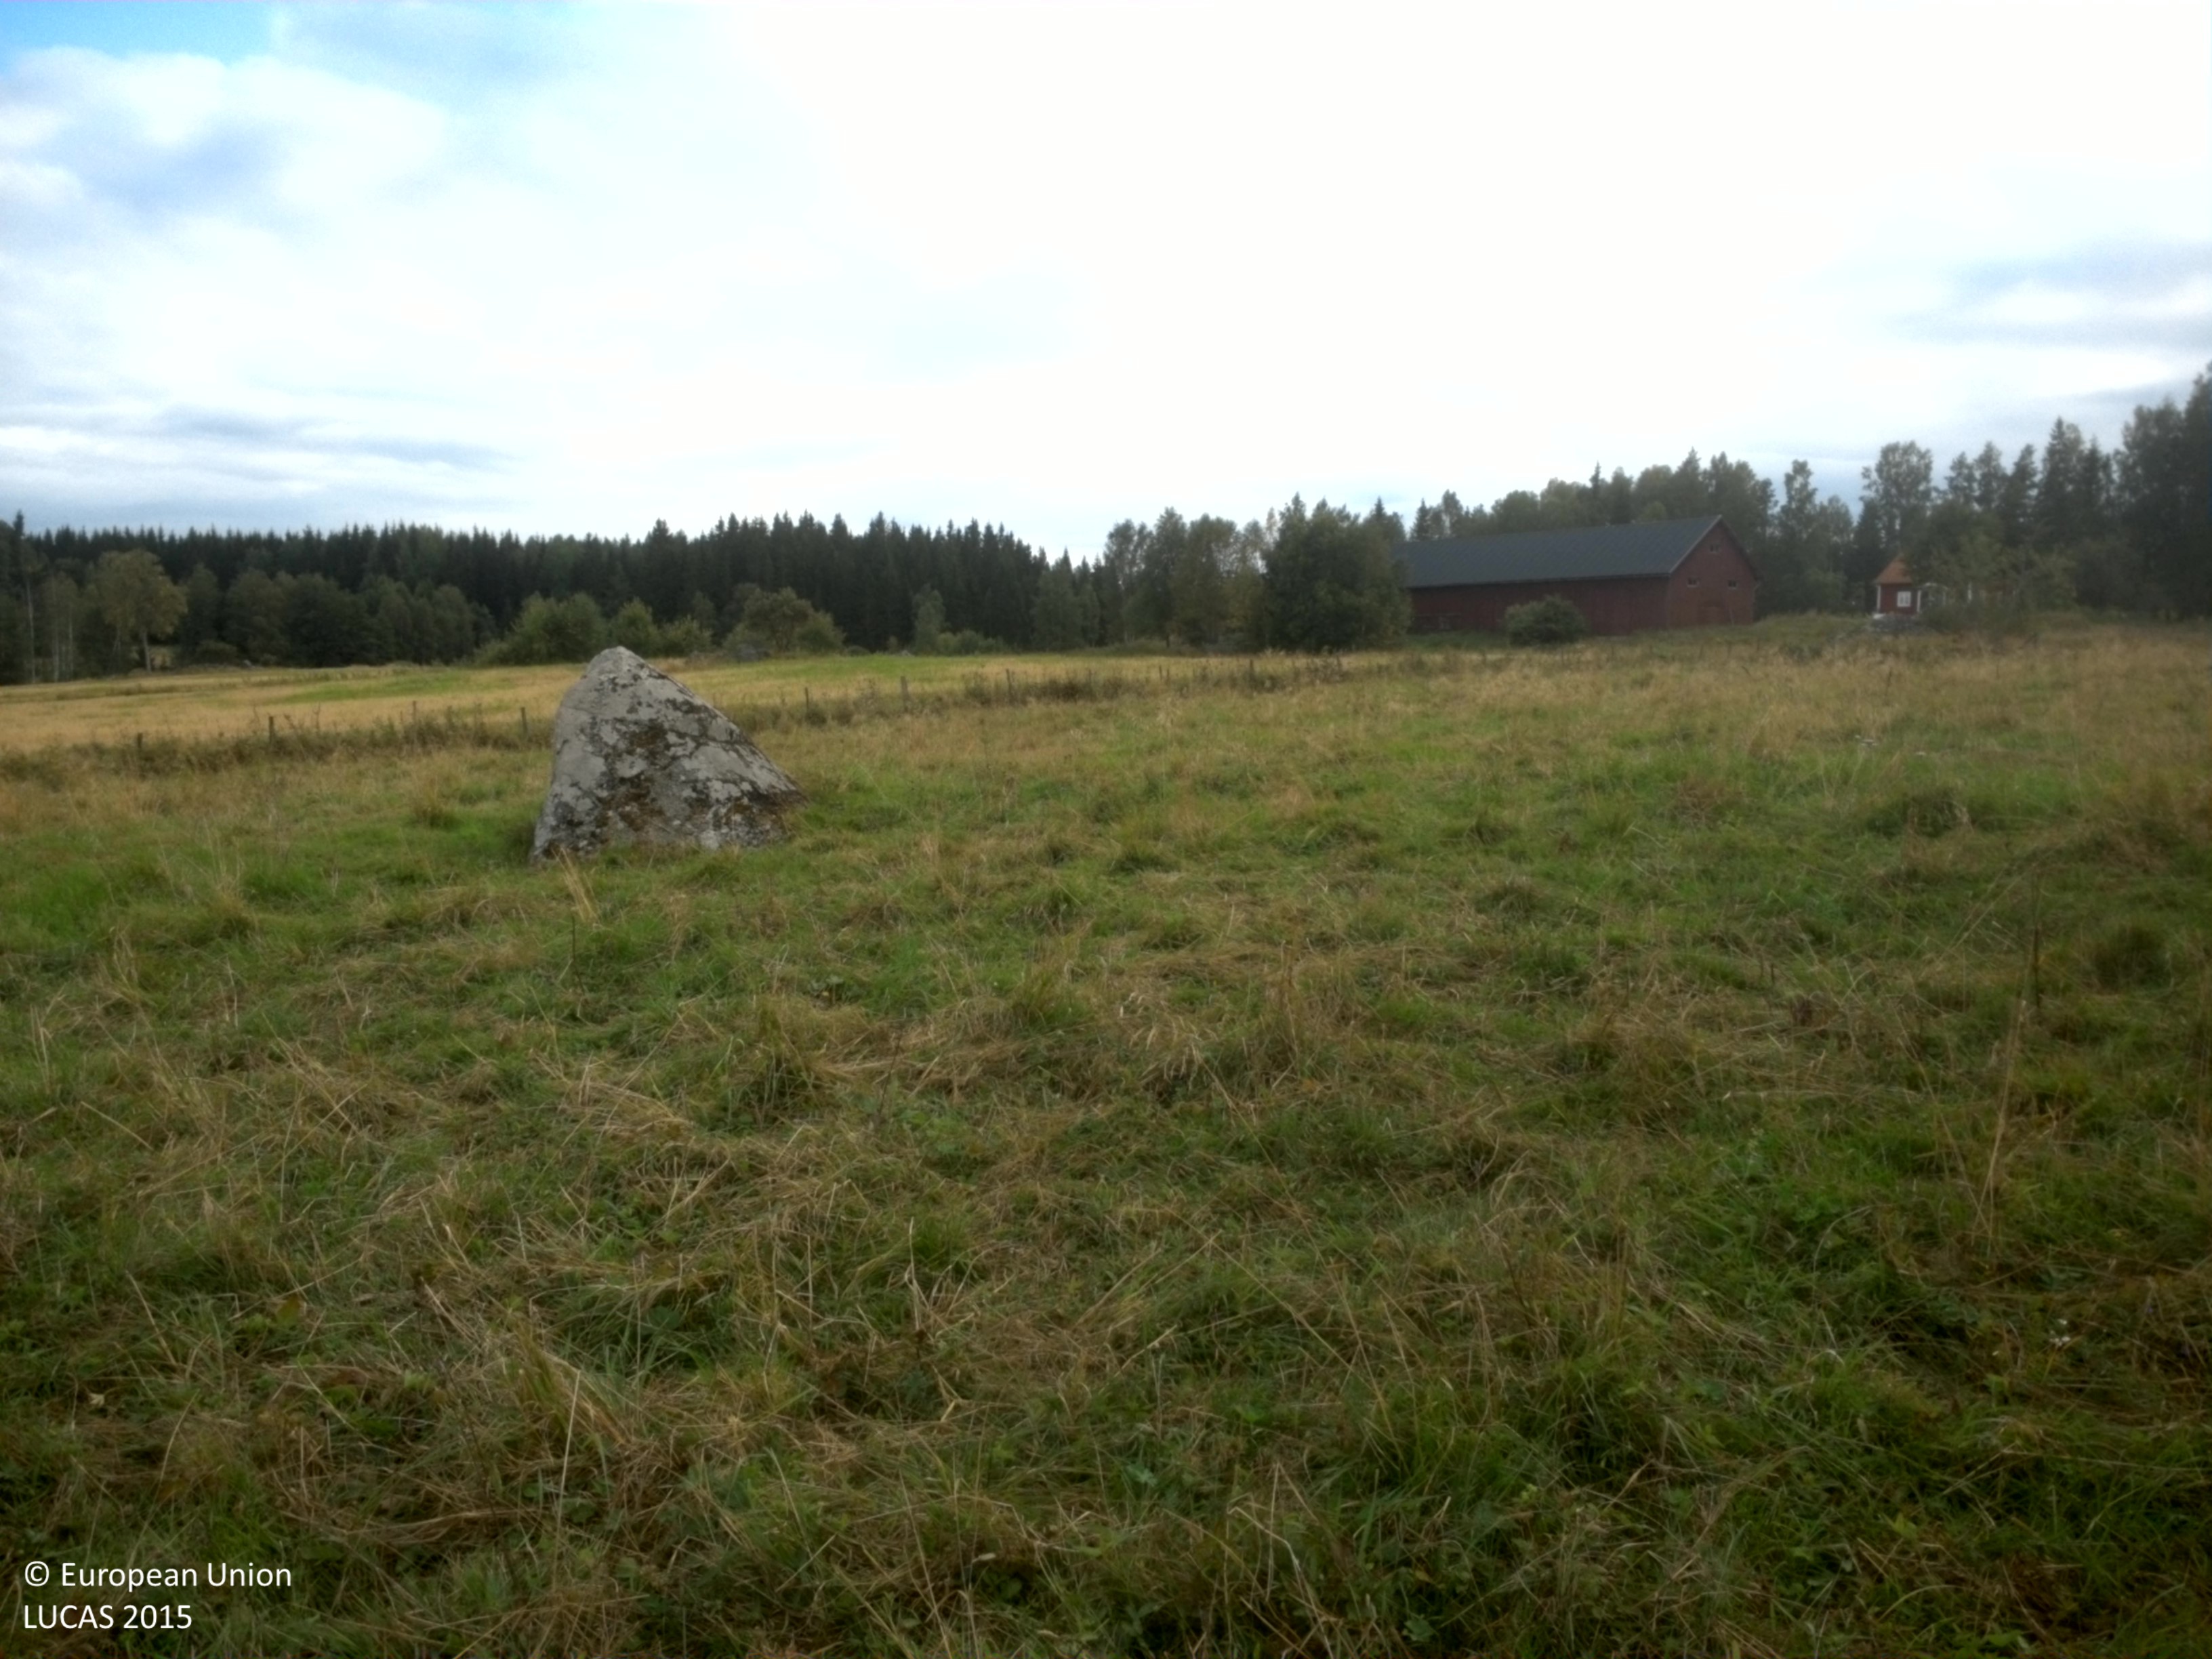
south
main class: Grassland
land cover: Grassland with sparse tree/shrub cover
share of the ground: > 75 %
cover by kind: herbaceous plants 90 %, broadleaved forest trees 5 %, shrubs 5 %
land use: Agriculture (excluding fallow land and kitchen gardens)
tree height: > 5 m
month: August
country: SE
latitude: 59.7047
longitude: 15.6954
